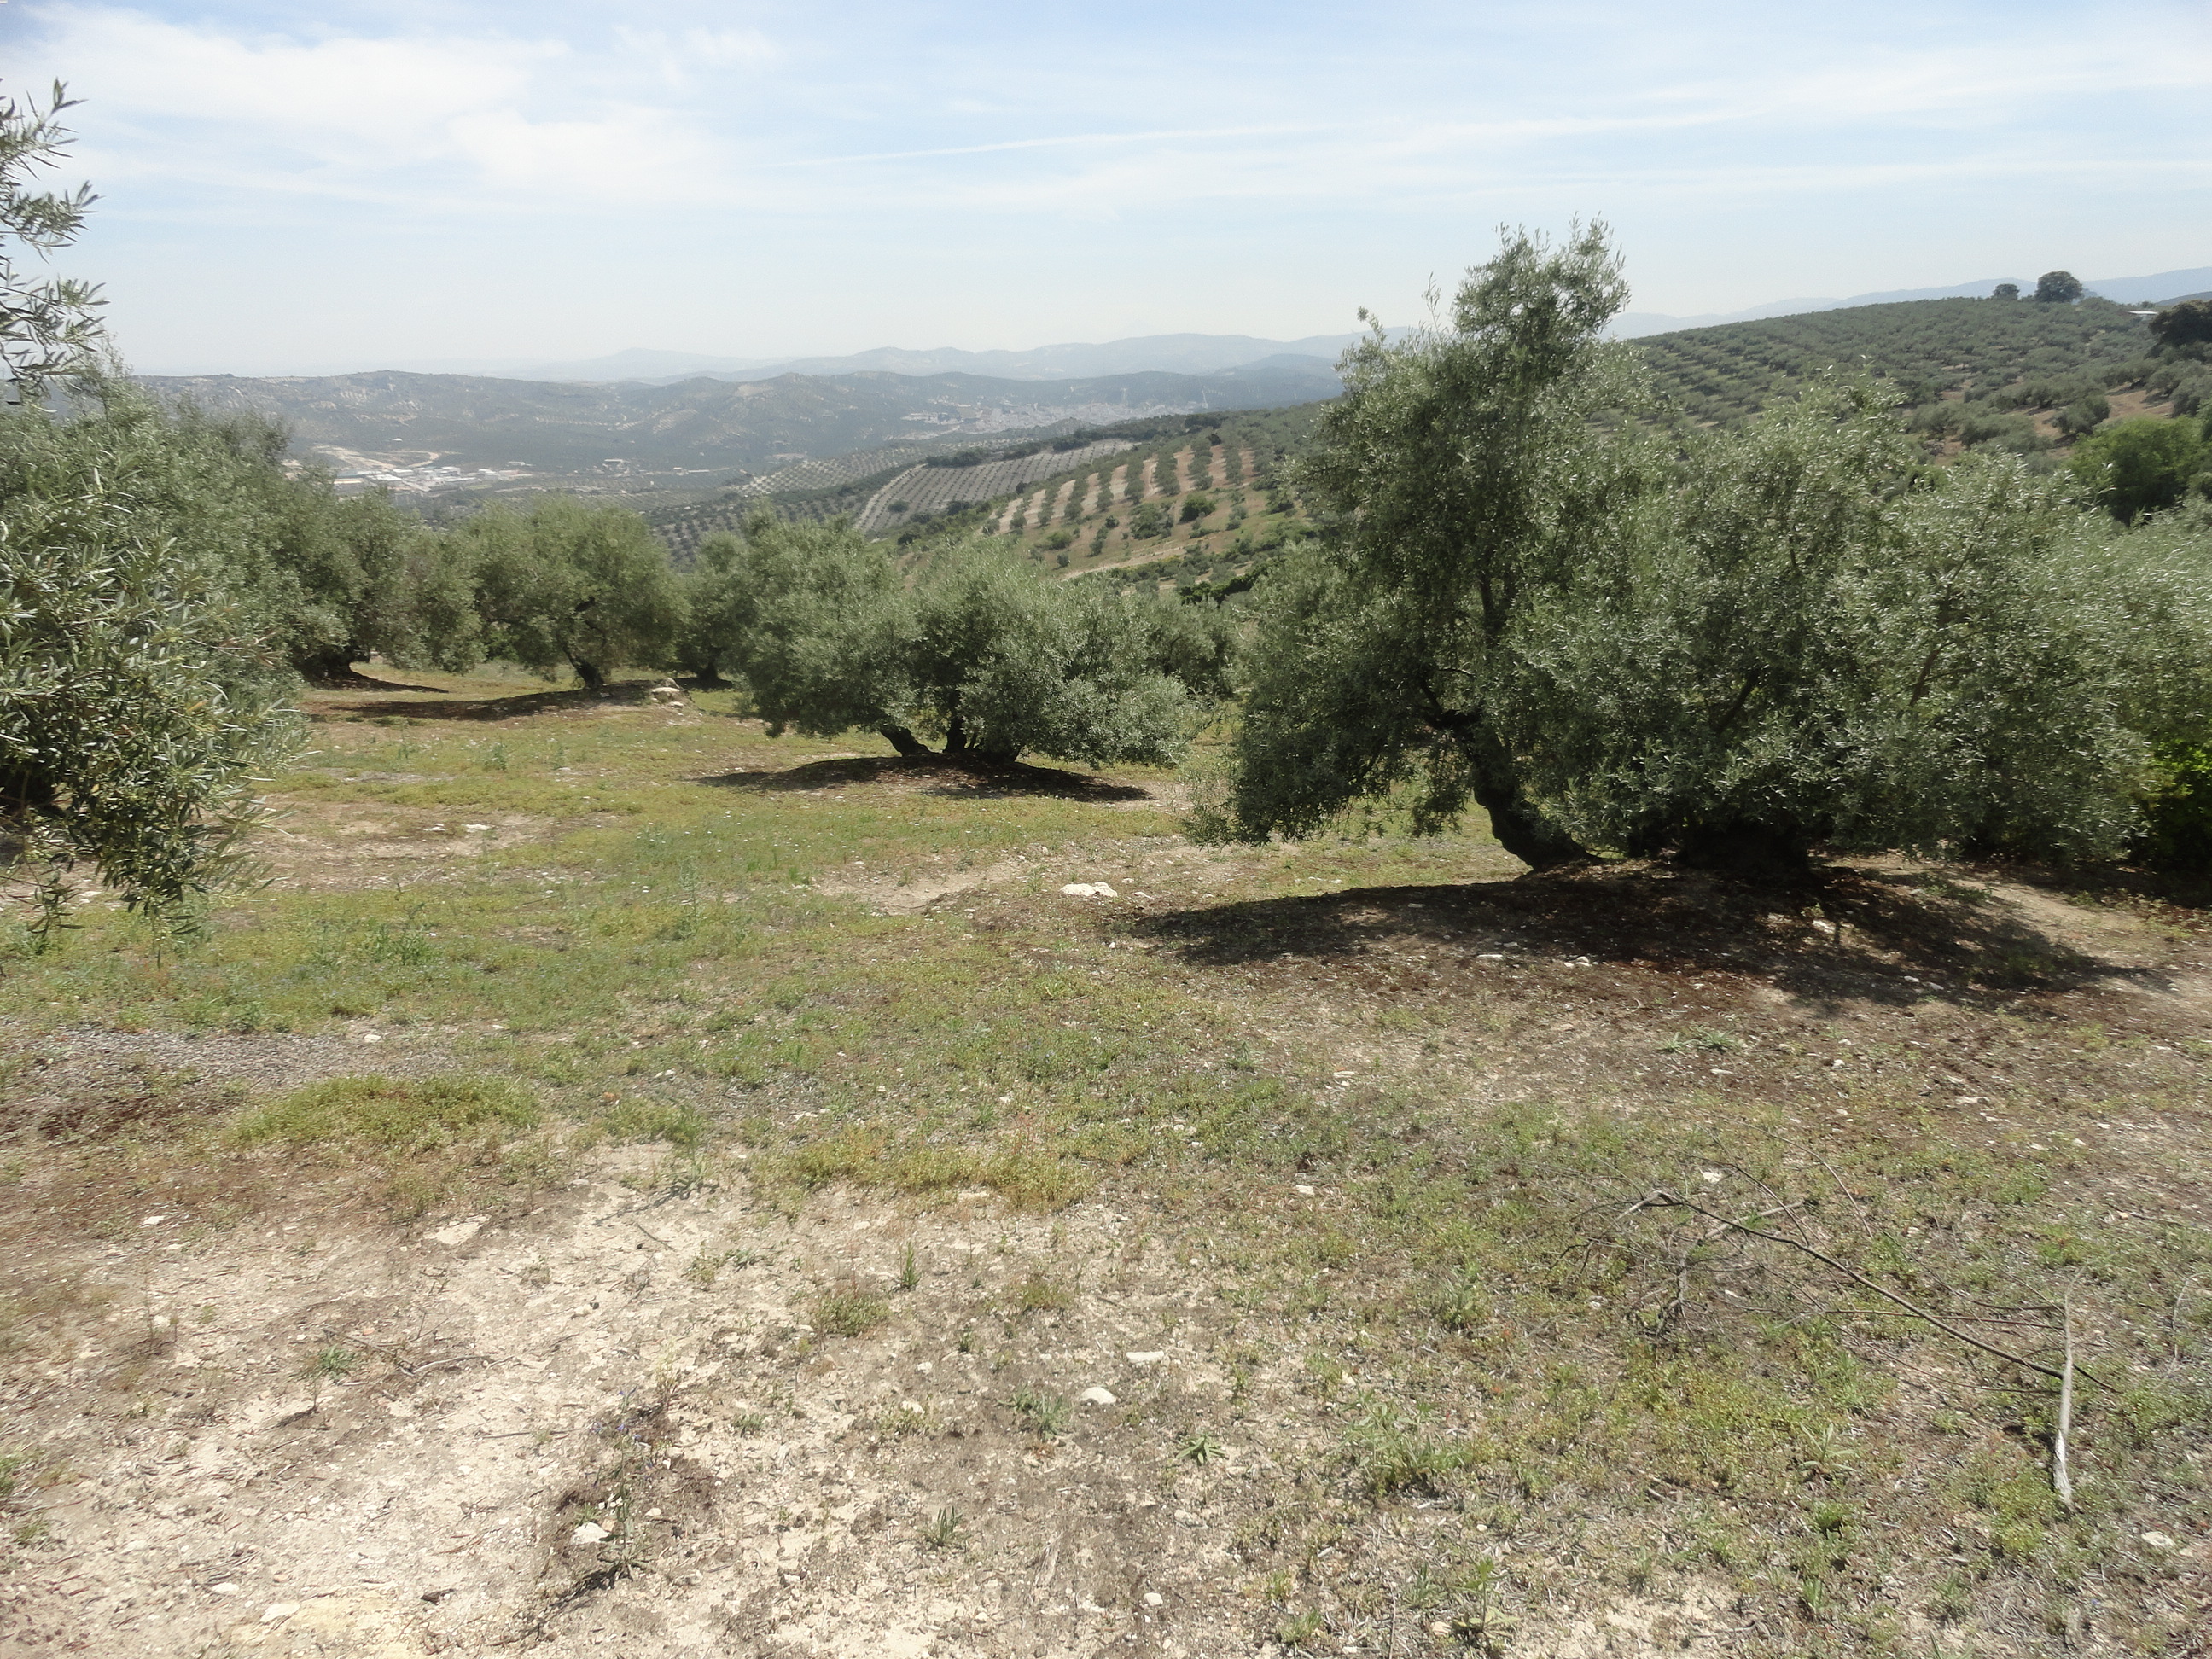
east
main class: Cropland
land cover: Olive groves
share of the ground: 25 - 50 %
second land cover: Spontaneously vegetated surfaces
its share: 50 - 75 %
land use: Agriculture (excluding fallow land and kitchen gardens)
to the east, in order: Olive groves; Spontaneously vegetated surfaces; Other structural elements; Olive groves; Other structural elements; Olive groves; Other structural elements; Shrubland with sparse tree cover; Olive groves; Shrubland with sparse tree cover
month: April
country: ES
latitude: 37.5840
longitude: -4.5122
